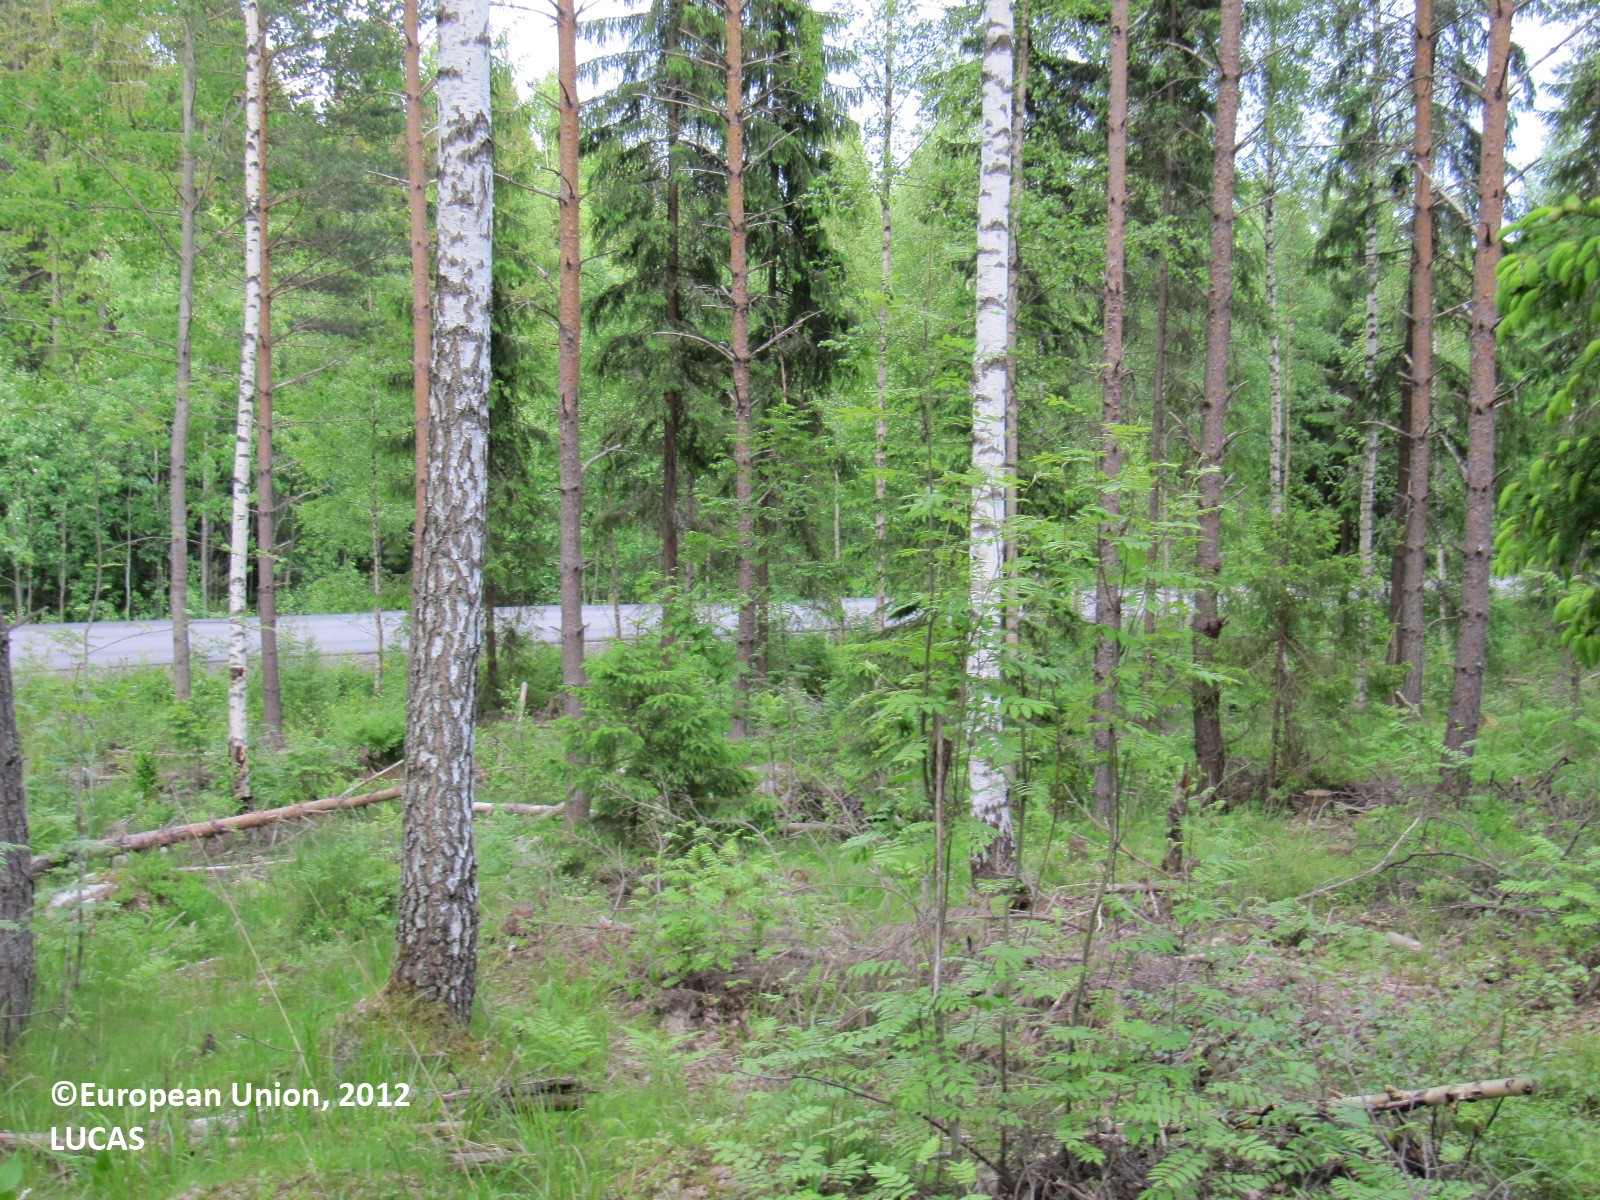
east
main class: Woodland
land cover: Pine dominated mixed woodland
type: boreal forest
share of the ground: 50 - 75 %
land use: Forestry
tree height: > 5 m
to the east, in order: Pine dominated mixed woodland; Ditches and canals; Paved roads, cycling and walking lanes; Ditches and canals; Spruce dominated mixed woodland; Ditches and canals; Grassland without tree/shrub cover
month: June
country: FI
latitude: 60.3077
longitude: 24.3110
